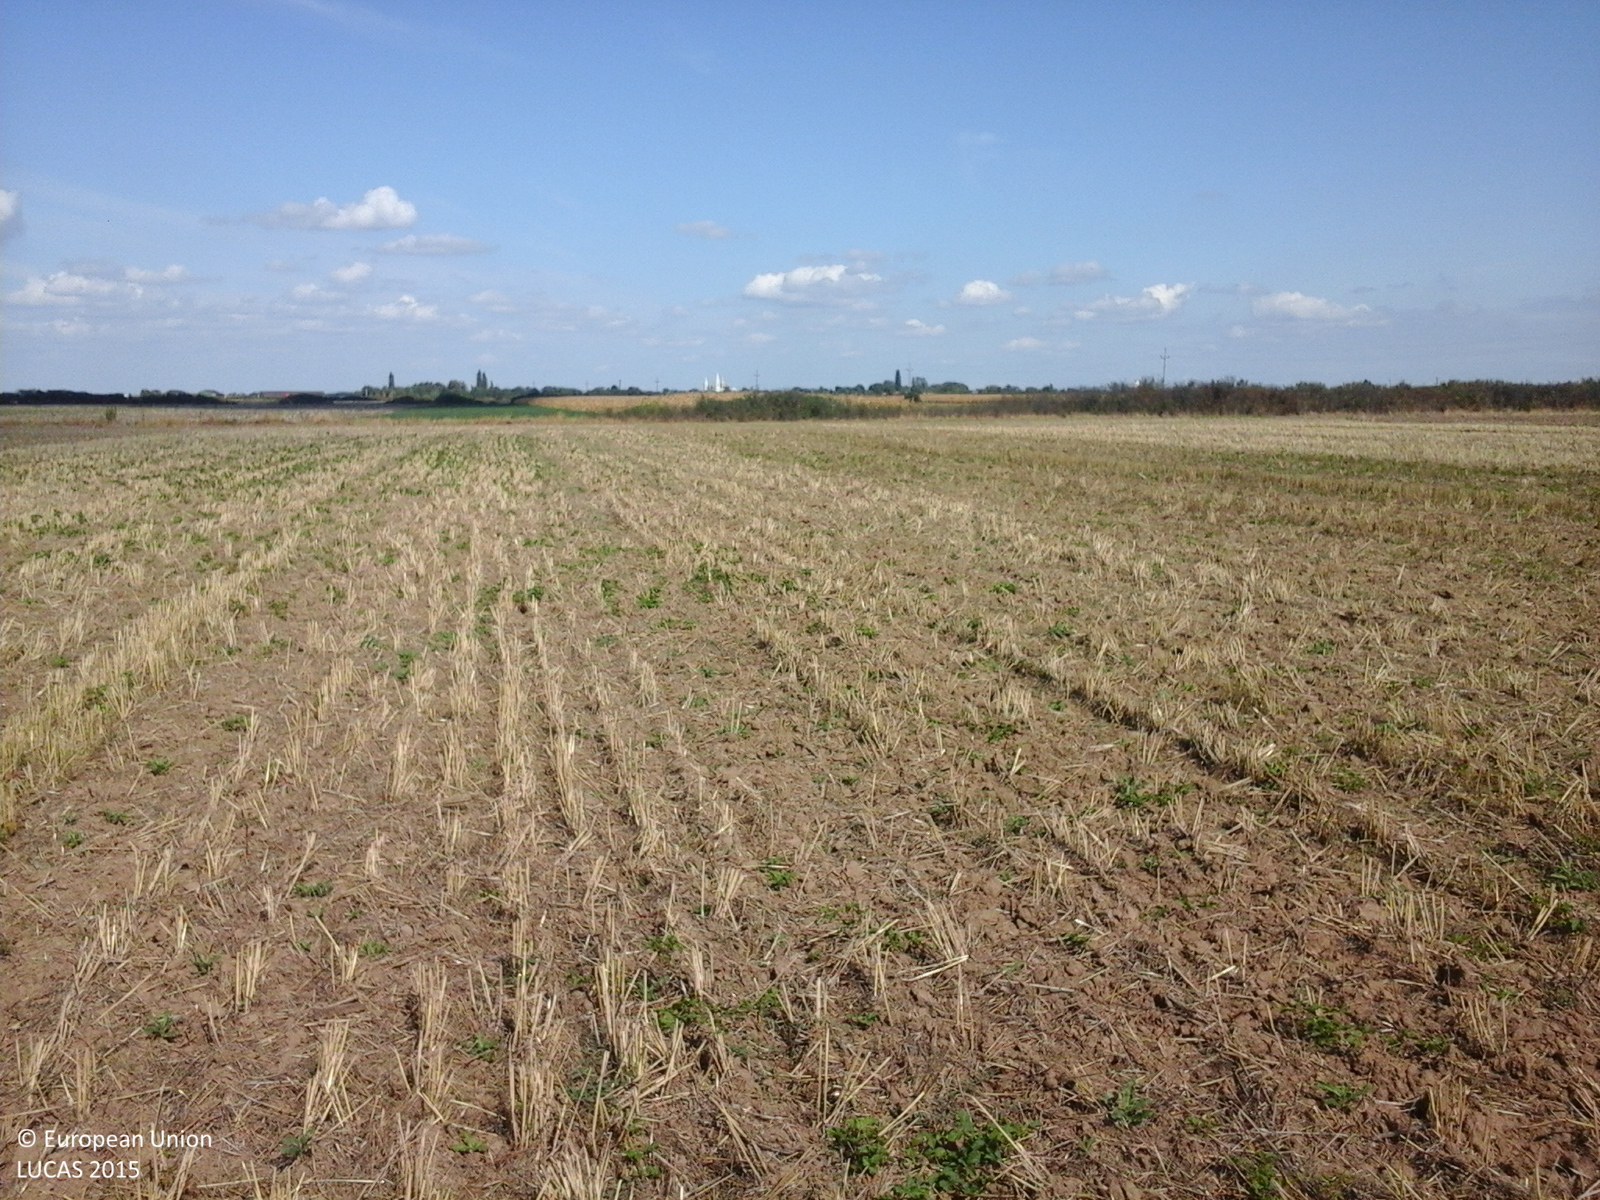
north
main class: Cropland
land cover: Durum wheat
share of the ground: 25 - 50 %
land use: Agriculture (excluding fallow land and kitchen gardens)
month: September
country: RO
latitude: 47.5938
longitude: 22.7080
